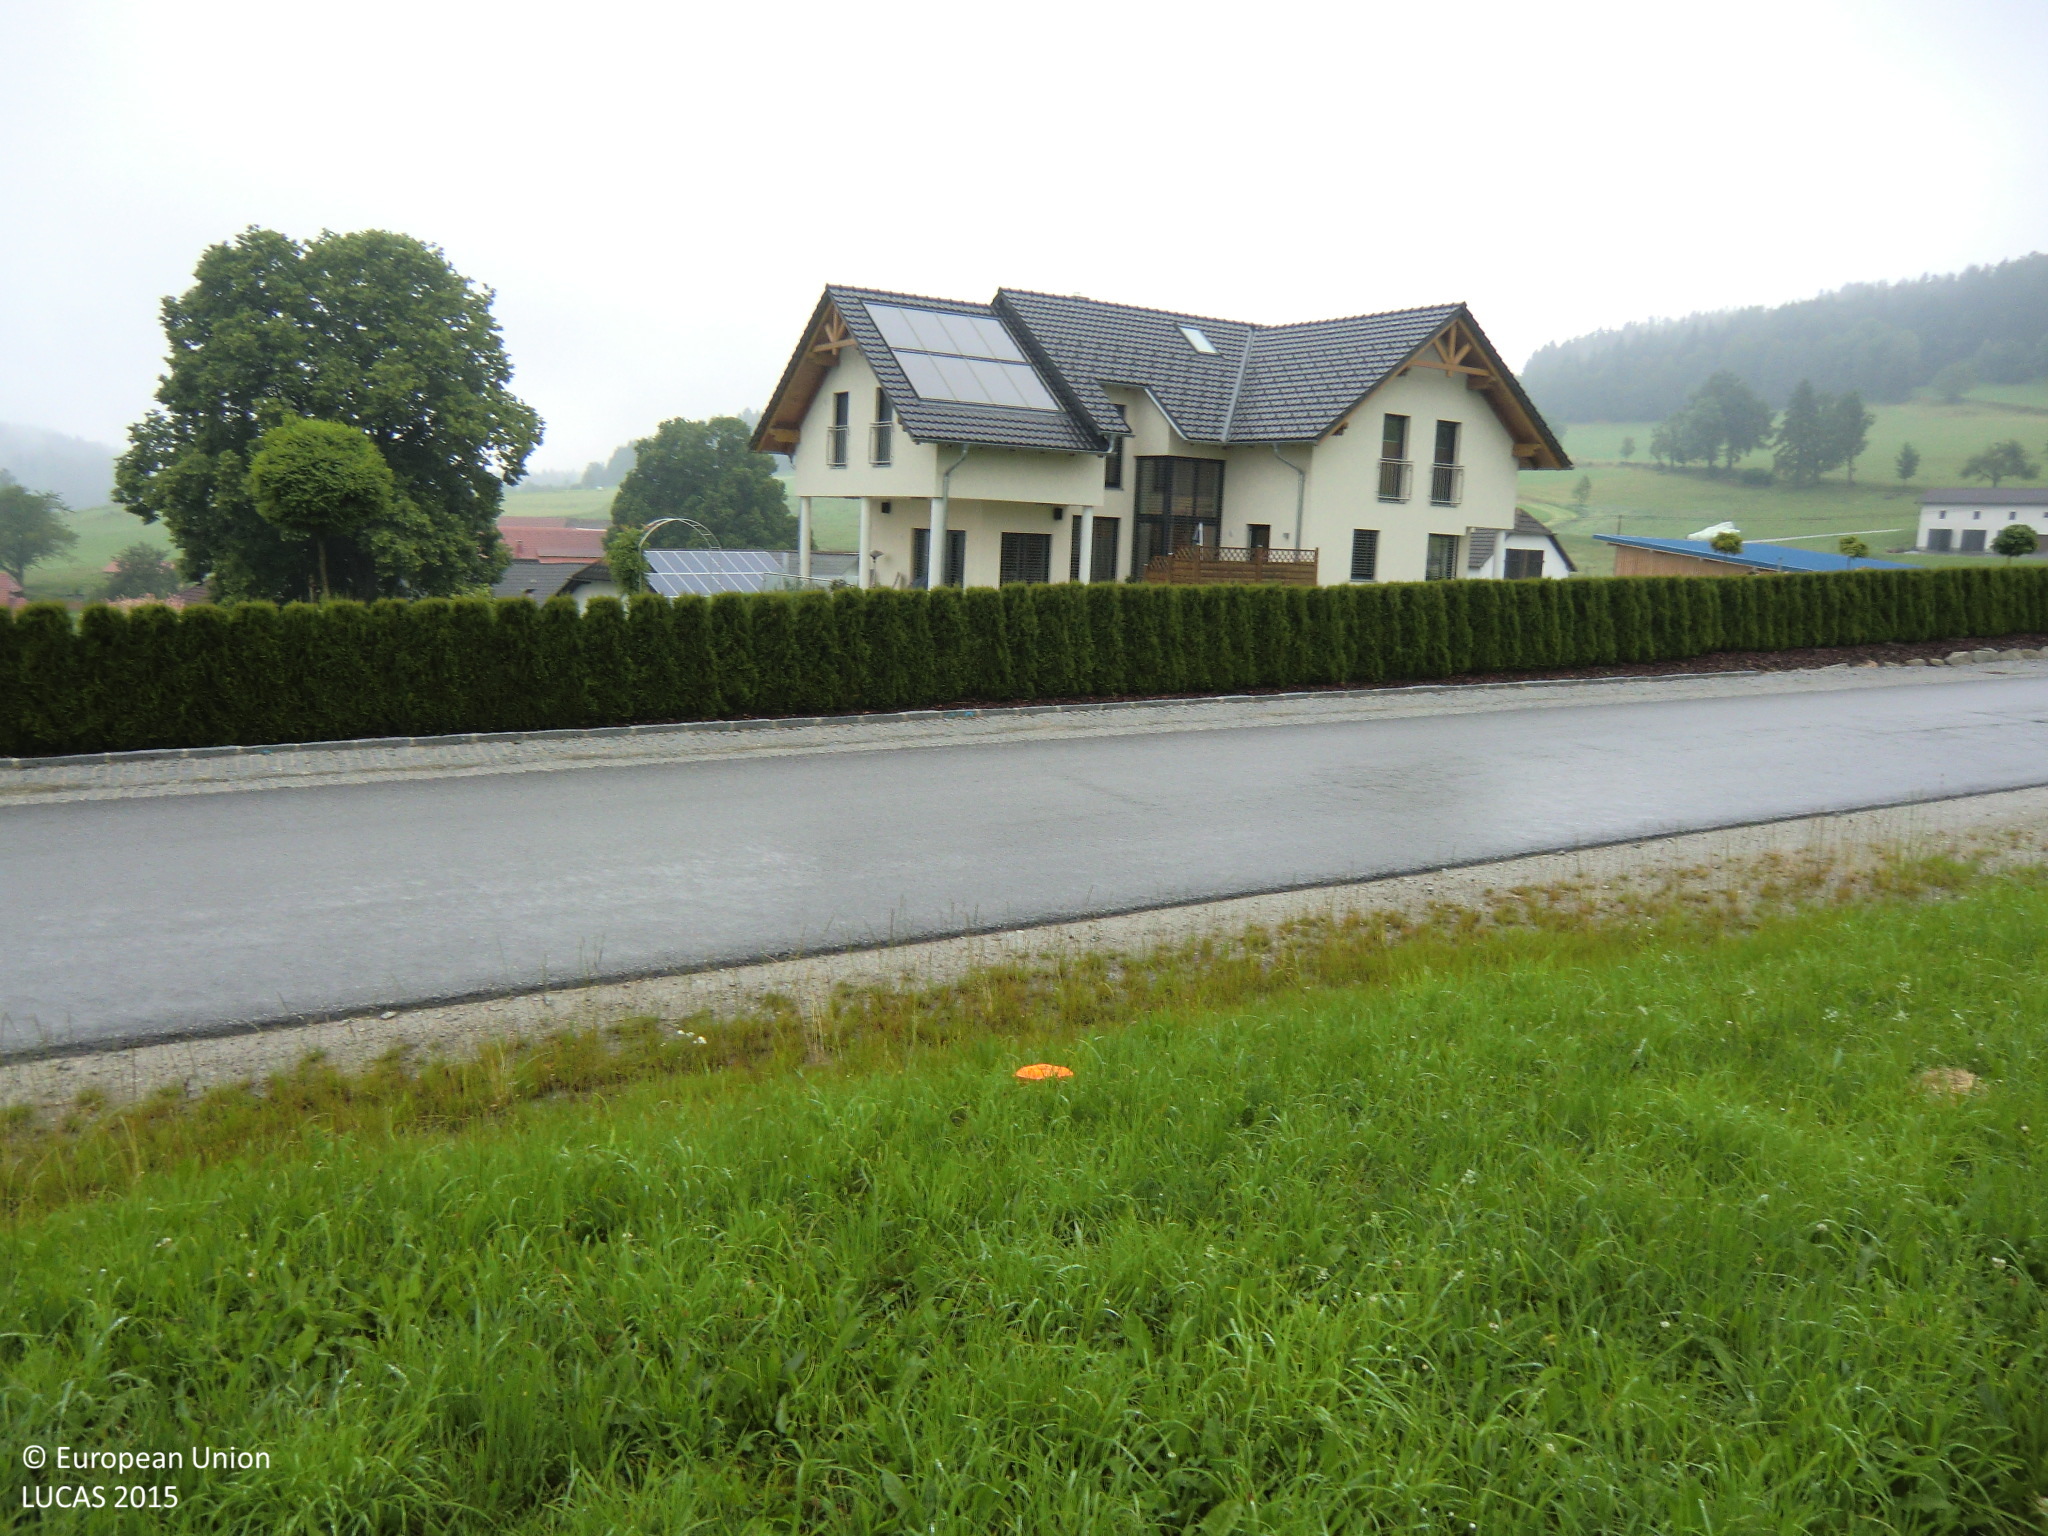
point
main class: Grassland
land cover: Grassland without tree/shrub cover
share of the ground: > 75 %
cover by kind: herbaceous plants 100 %
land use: Agriculture (excluding fallow land and kitchen gardens)
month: June
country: AT
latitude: 48.5974
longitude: 14.5705
